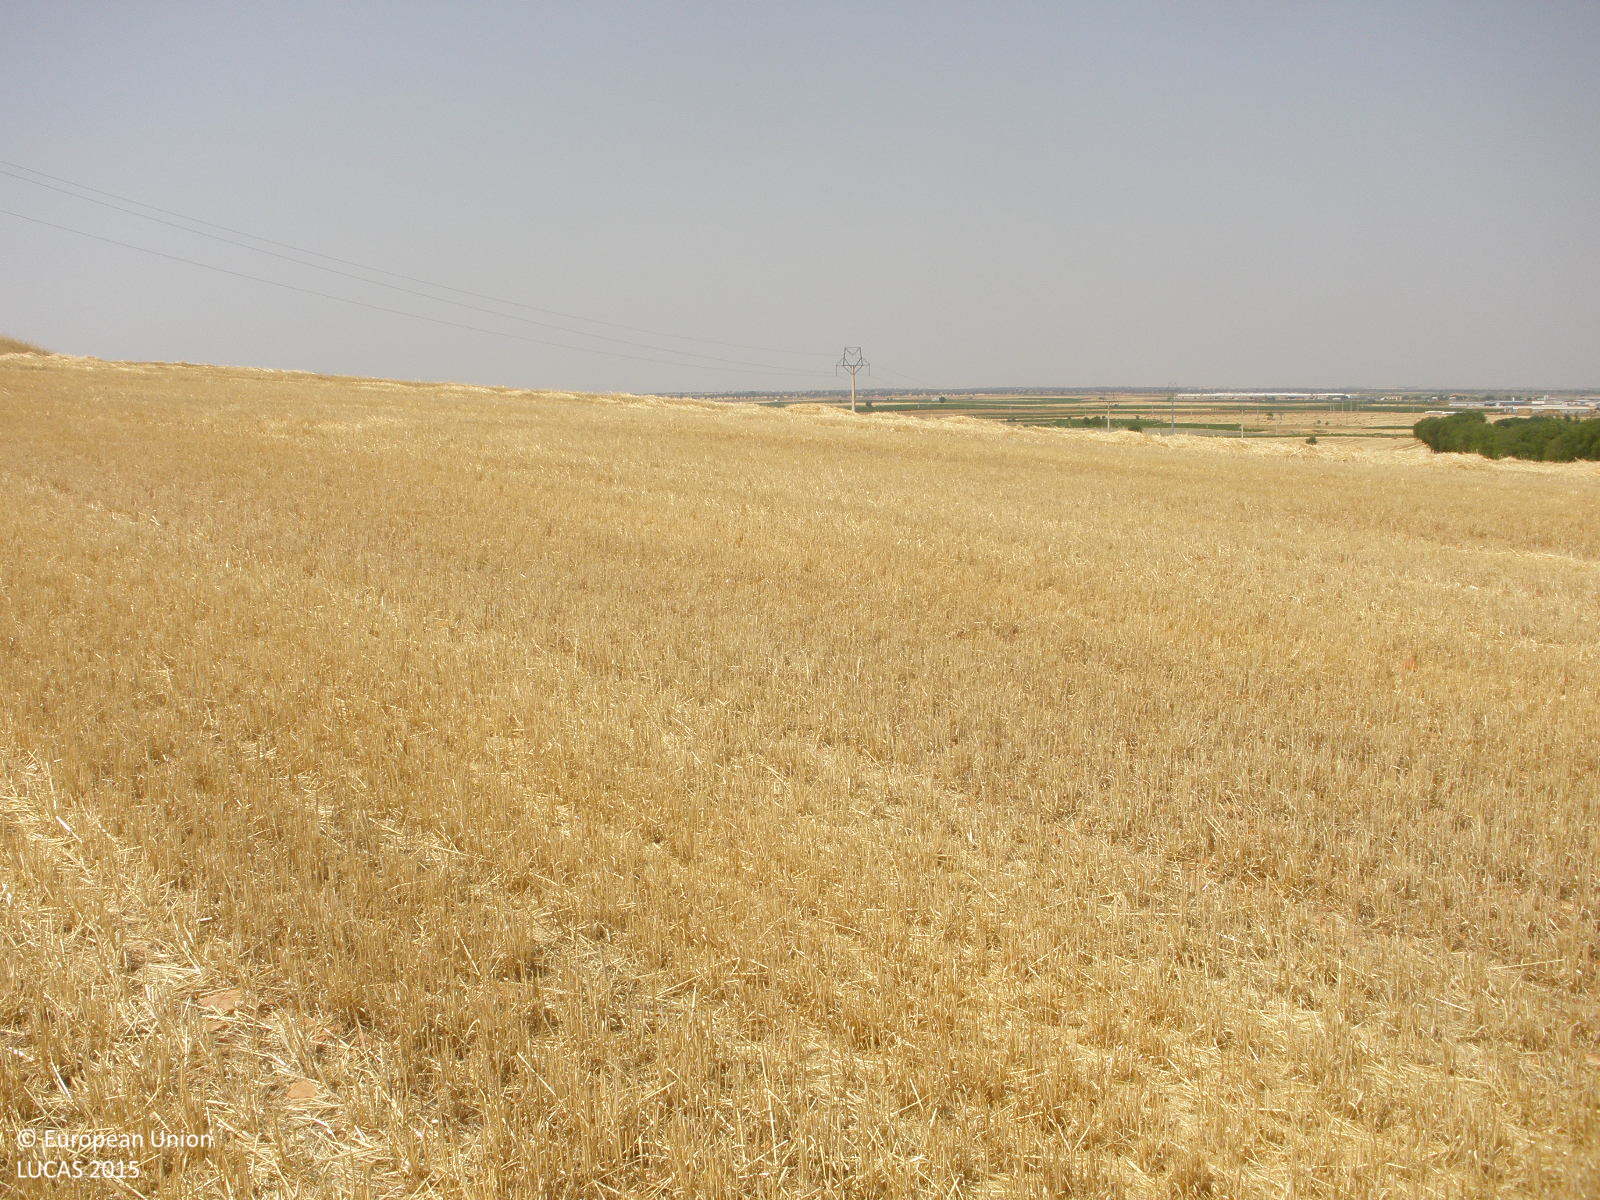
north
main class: Cropland
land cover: Common wheat
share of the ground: < 10 %
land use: Agriculture (excluding fallow land and kitchen gardens)
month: July
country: ES
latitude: 39.7378
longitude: -3.1964
